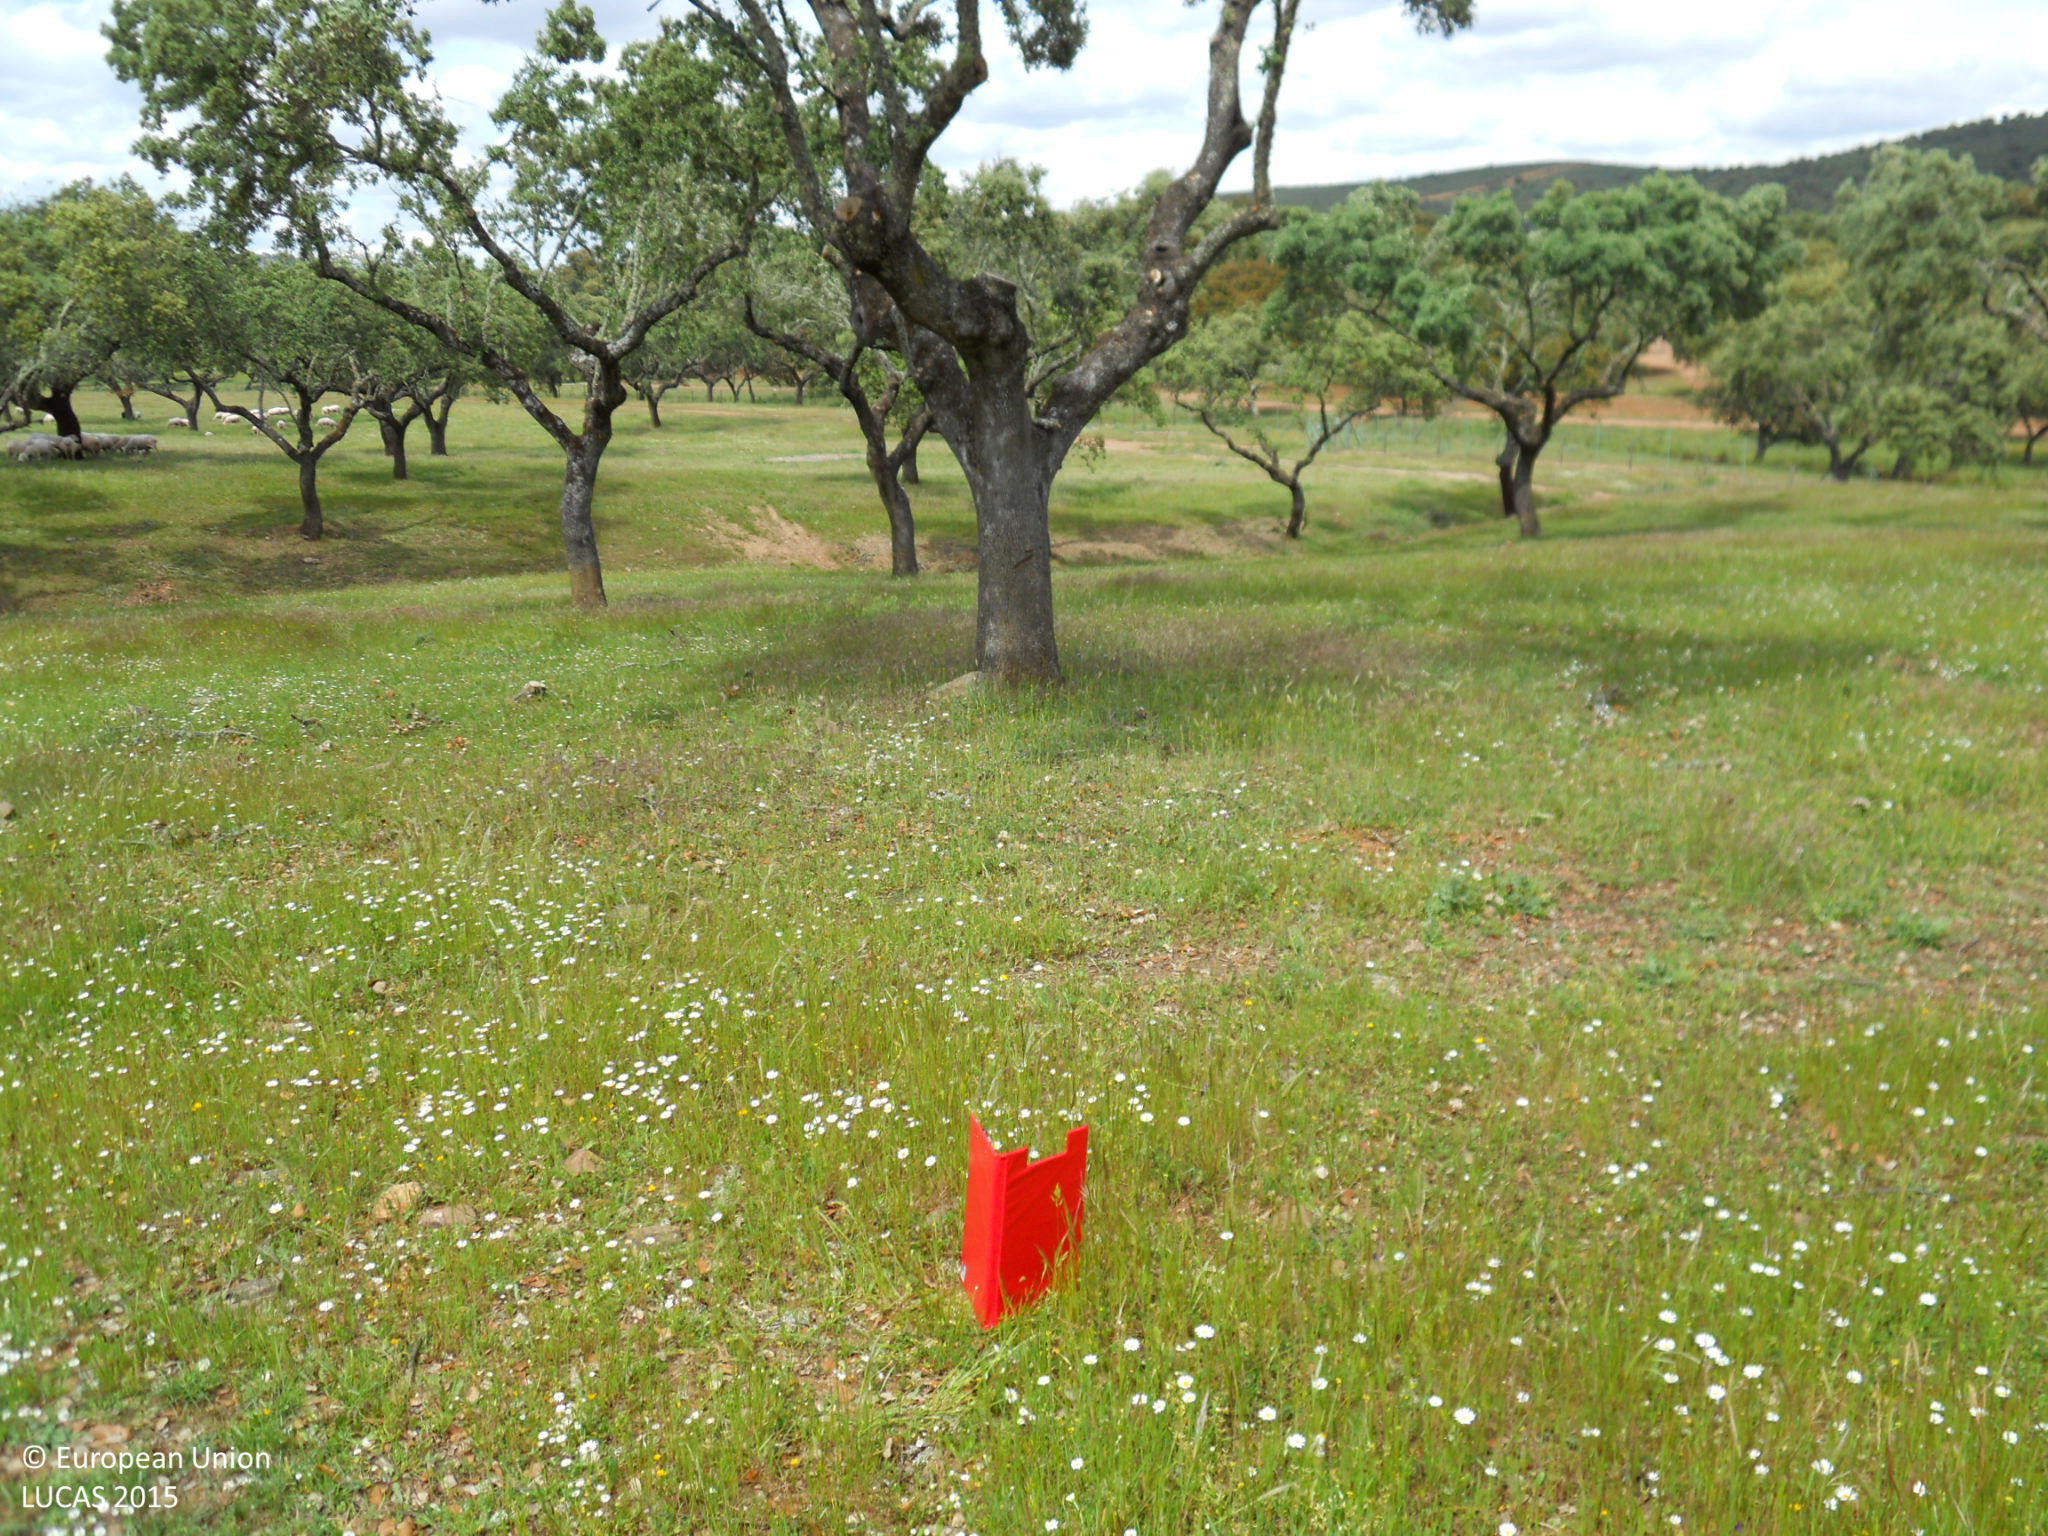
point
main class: Woodland
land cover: Broadleaved woodland
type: broadleaved evergreen forest
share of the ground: > 75 %
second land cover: Grassland without tree/shrub cover
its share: > 75 %
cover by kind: broadleaved forest trees 80 %, herbaceous plants 20 %
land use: Forestry
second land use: Agriculture (excluding fallow land and kitchen gardens)
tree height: > 5 m
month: April
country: ES
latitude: 39.3213
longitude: -6.5990
